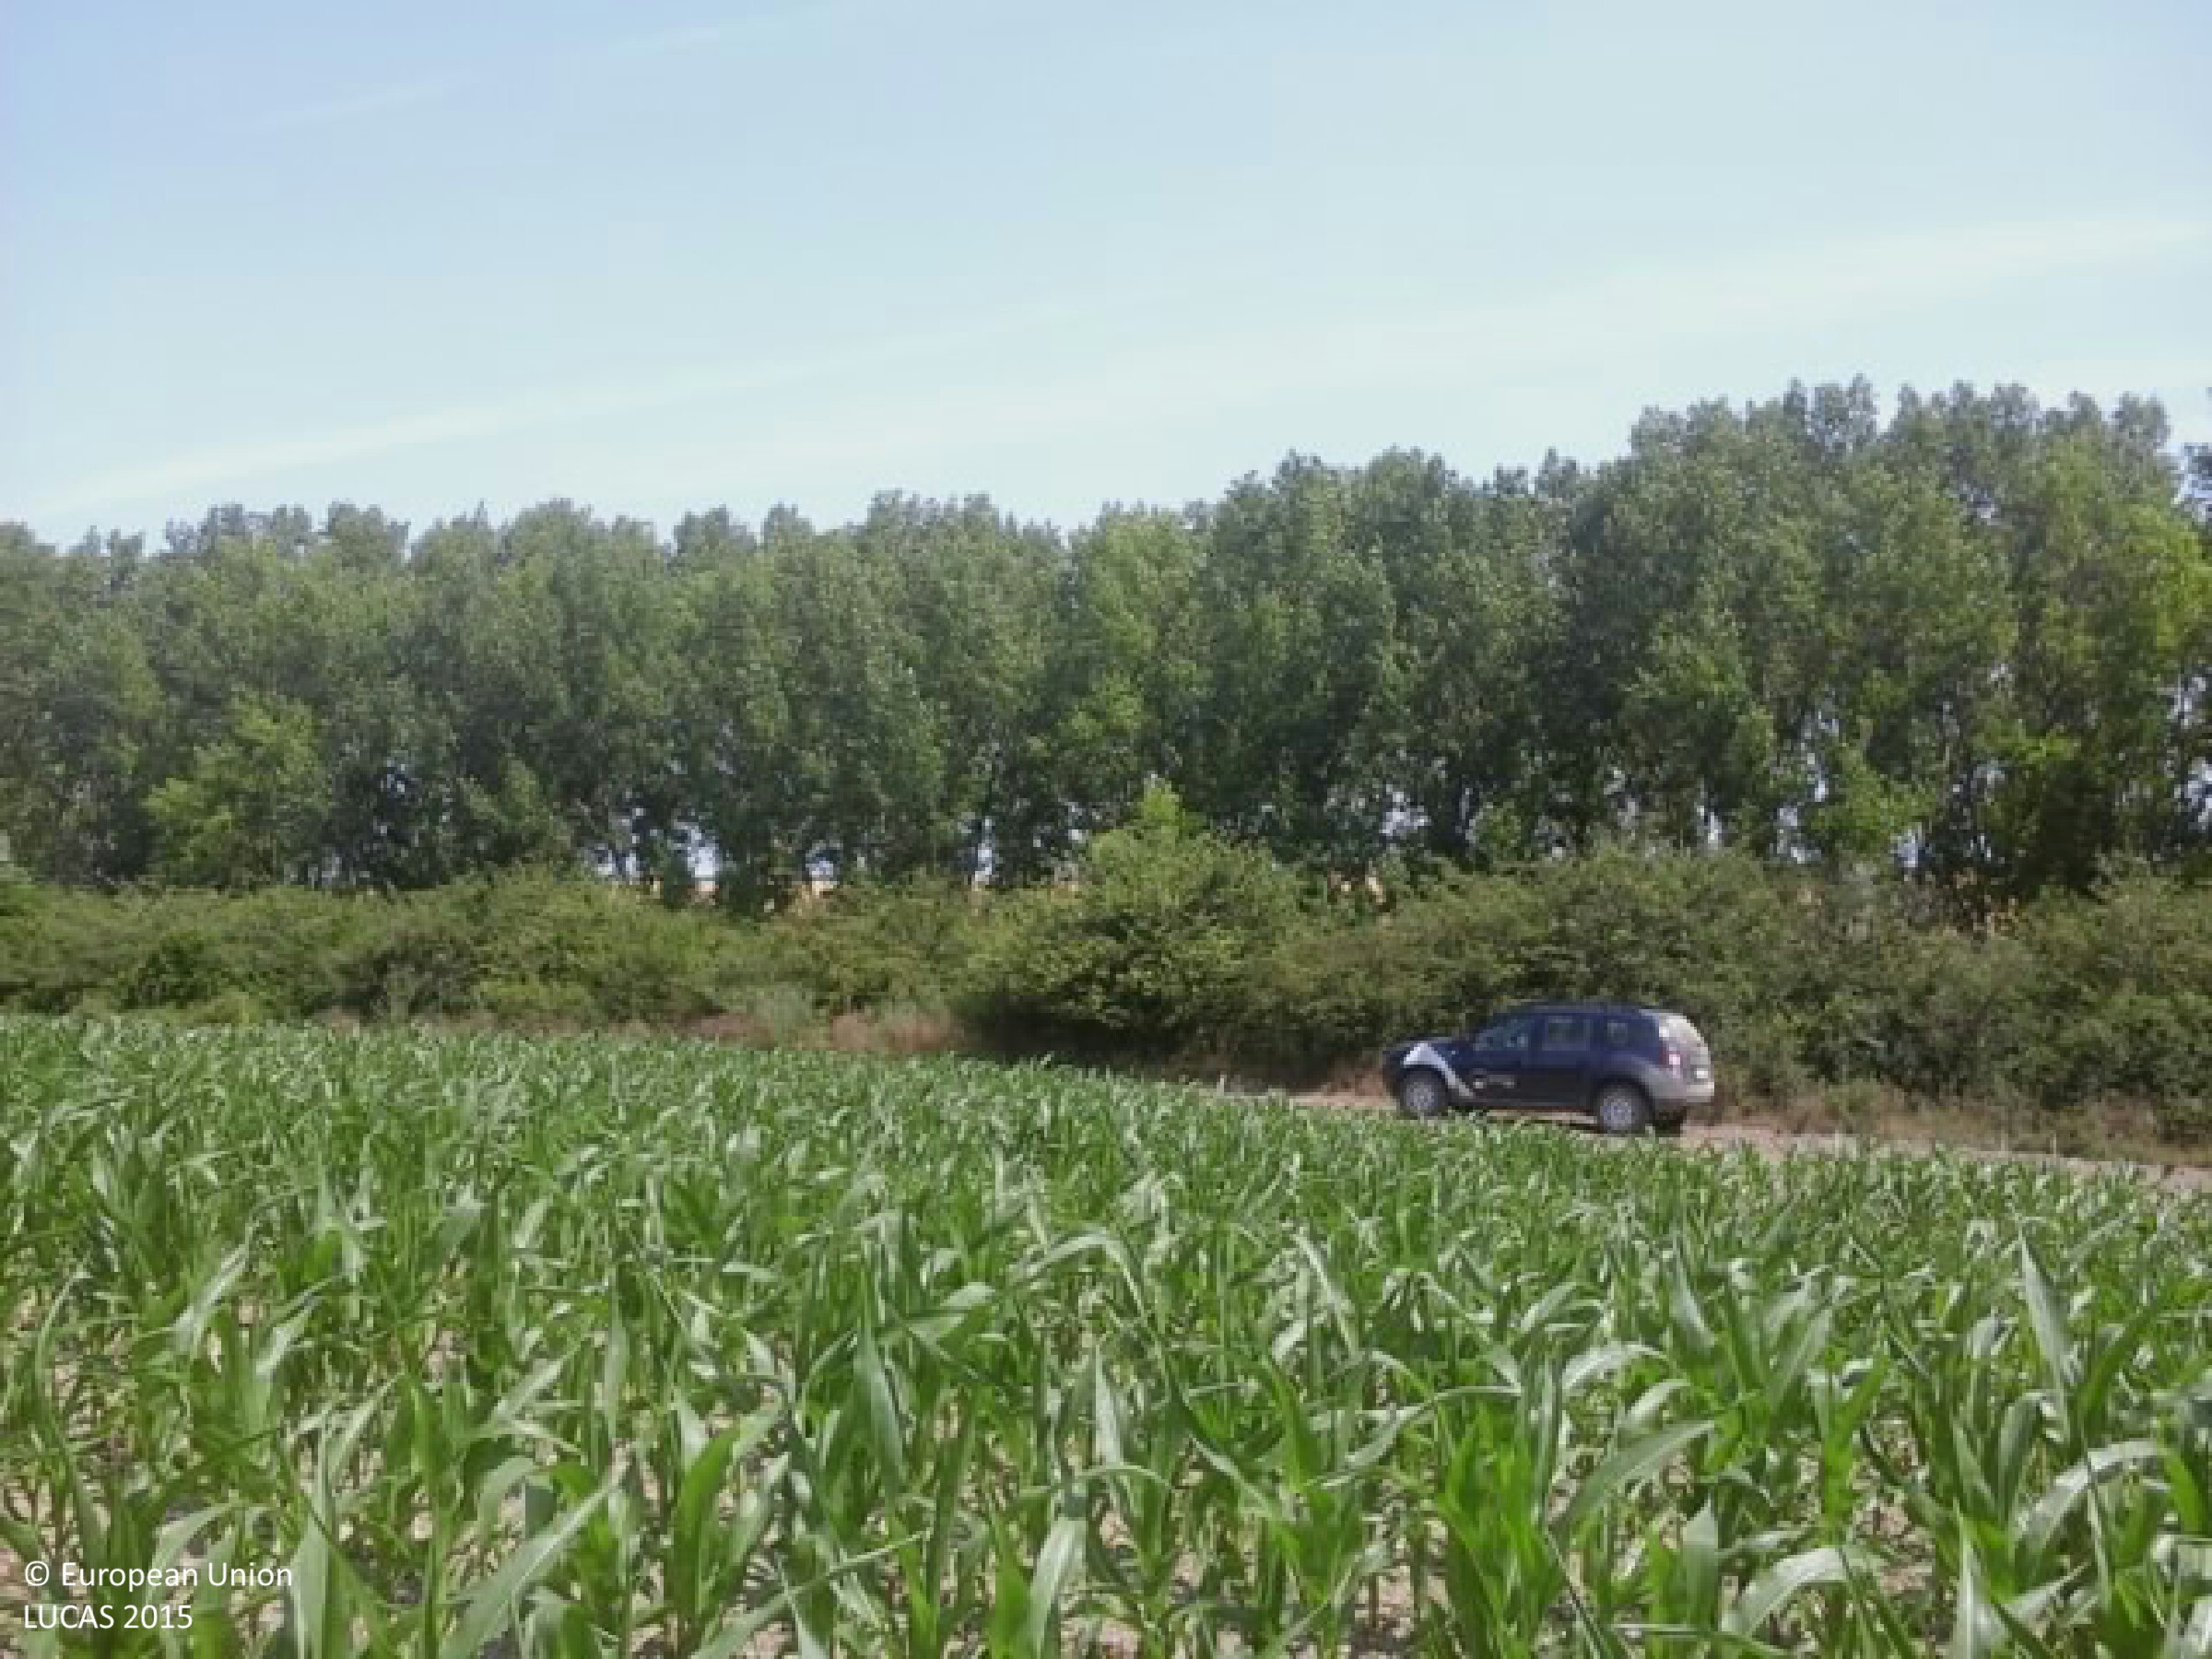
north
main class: Cropland
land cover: Maize
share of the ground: 50 - 75 %
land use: Agriculture (excluding fallow land and kitchen gardens)
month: July
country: HU
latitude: 46.7046
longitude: 18.8946
